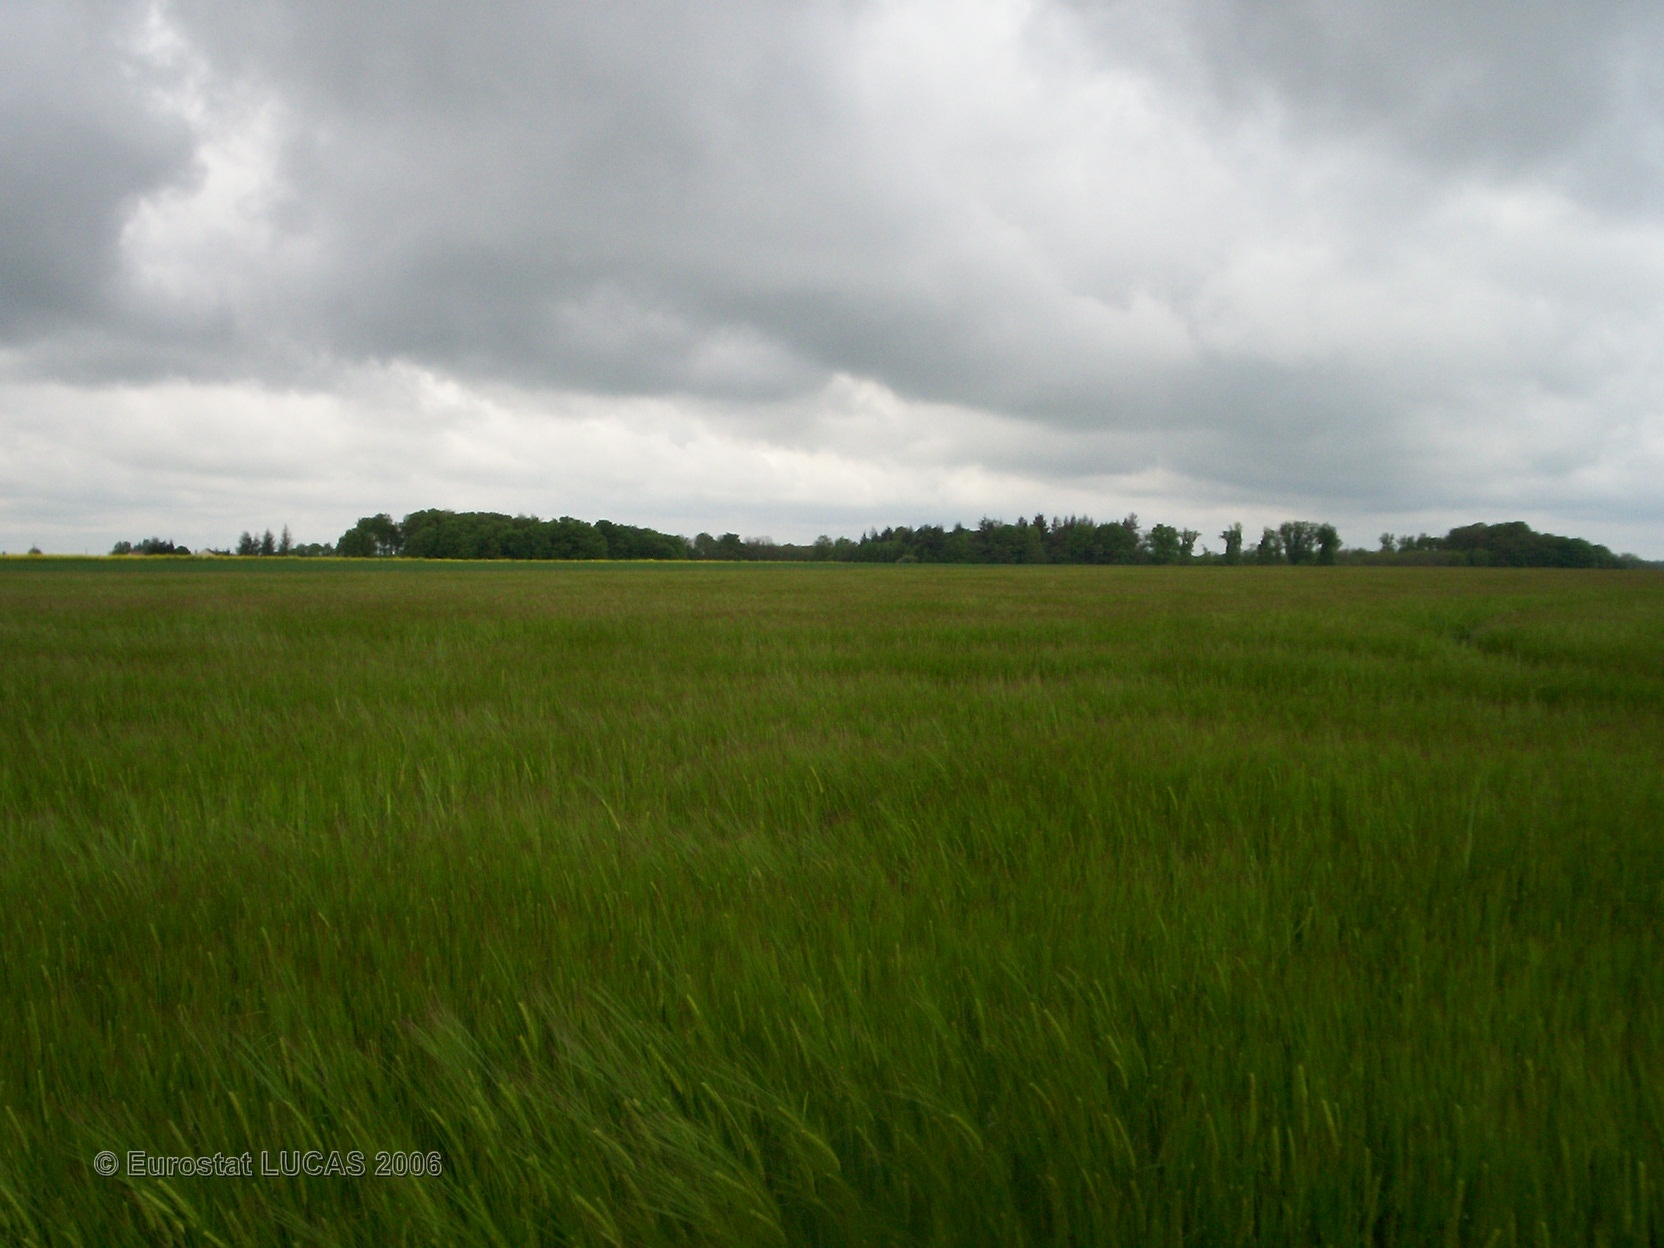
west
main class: Cropland
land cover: Barley
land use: Agriculture (excluding fallow land and kitchen gardens)
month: May
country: FR
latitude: 47.9982
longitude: 2.9566
